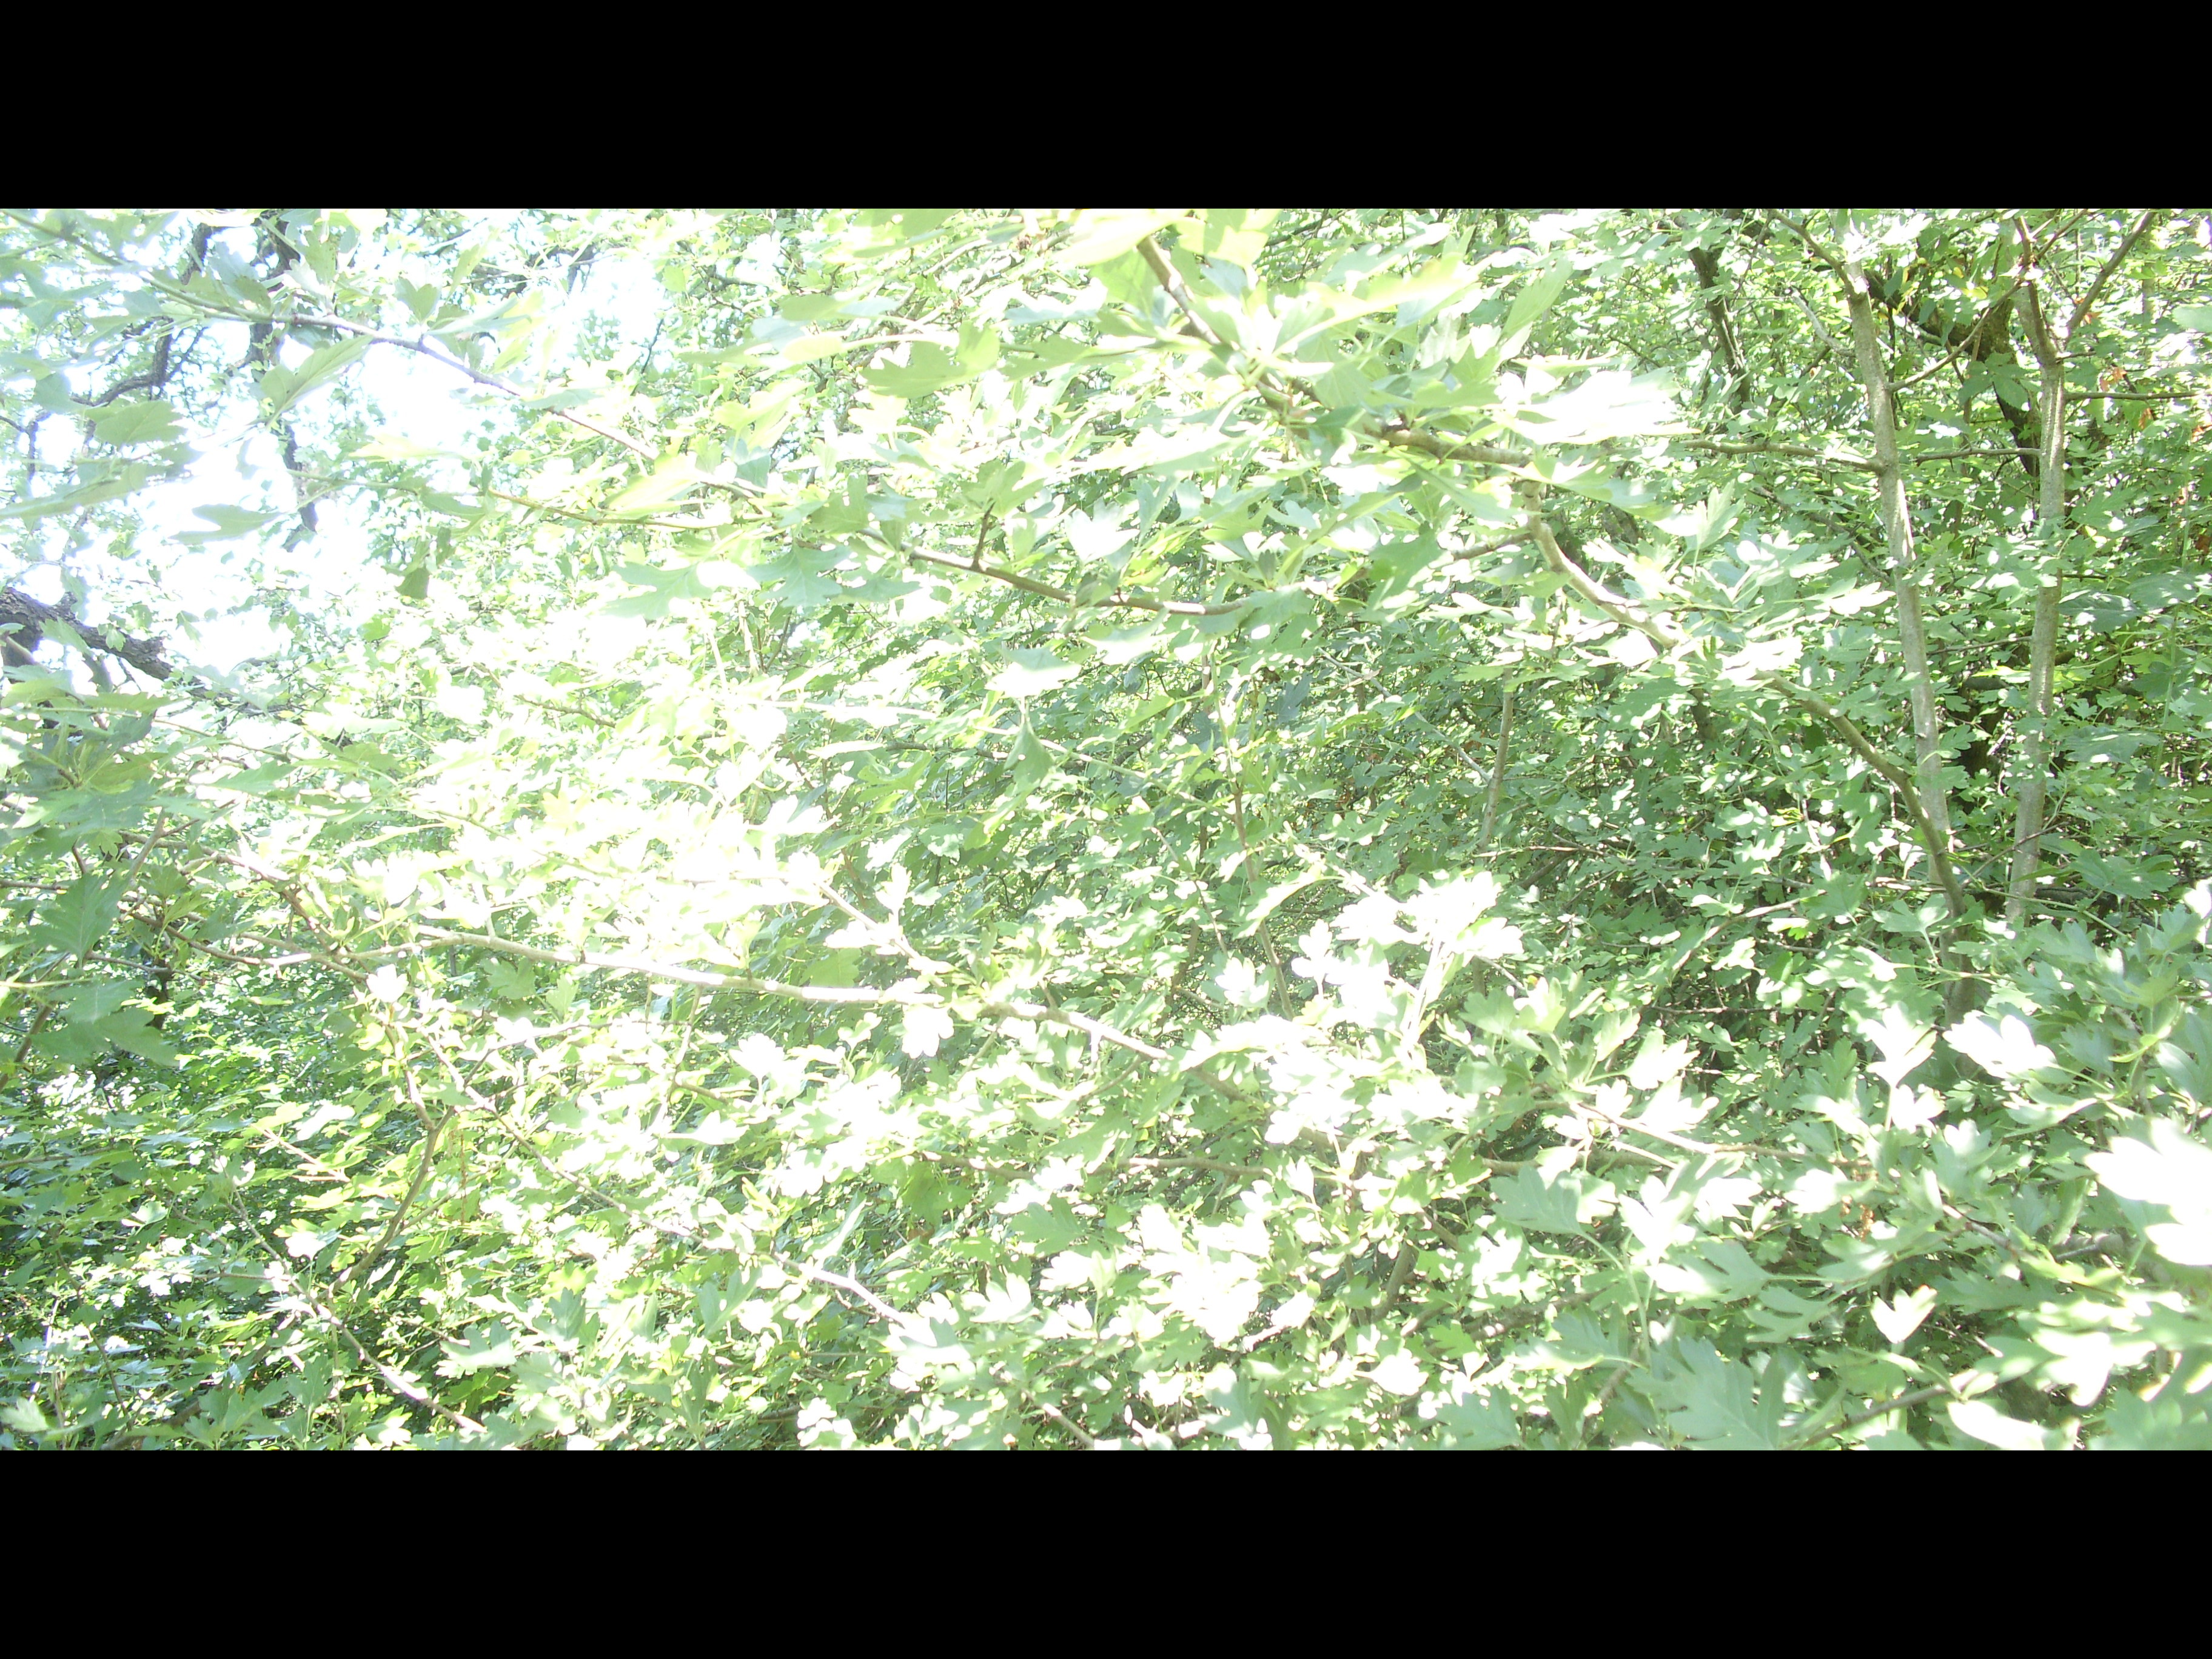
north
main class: Woodland
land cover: Broadleaved woodland
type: mesophytic deciduous forest
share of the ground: > 75 %
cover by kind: broadleaved forest trees 95 %, shrubs 5 %
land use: Forestry
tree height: > 5 m
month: June
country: BG
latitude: 43.5886
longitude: 23.6597
